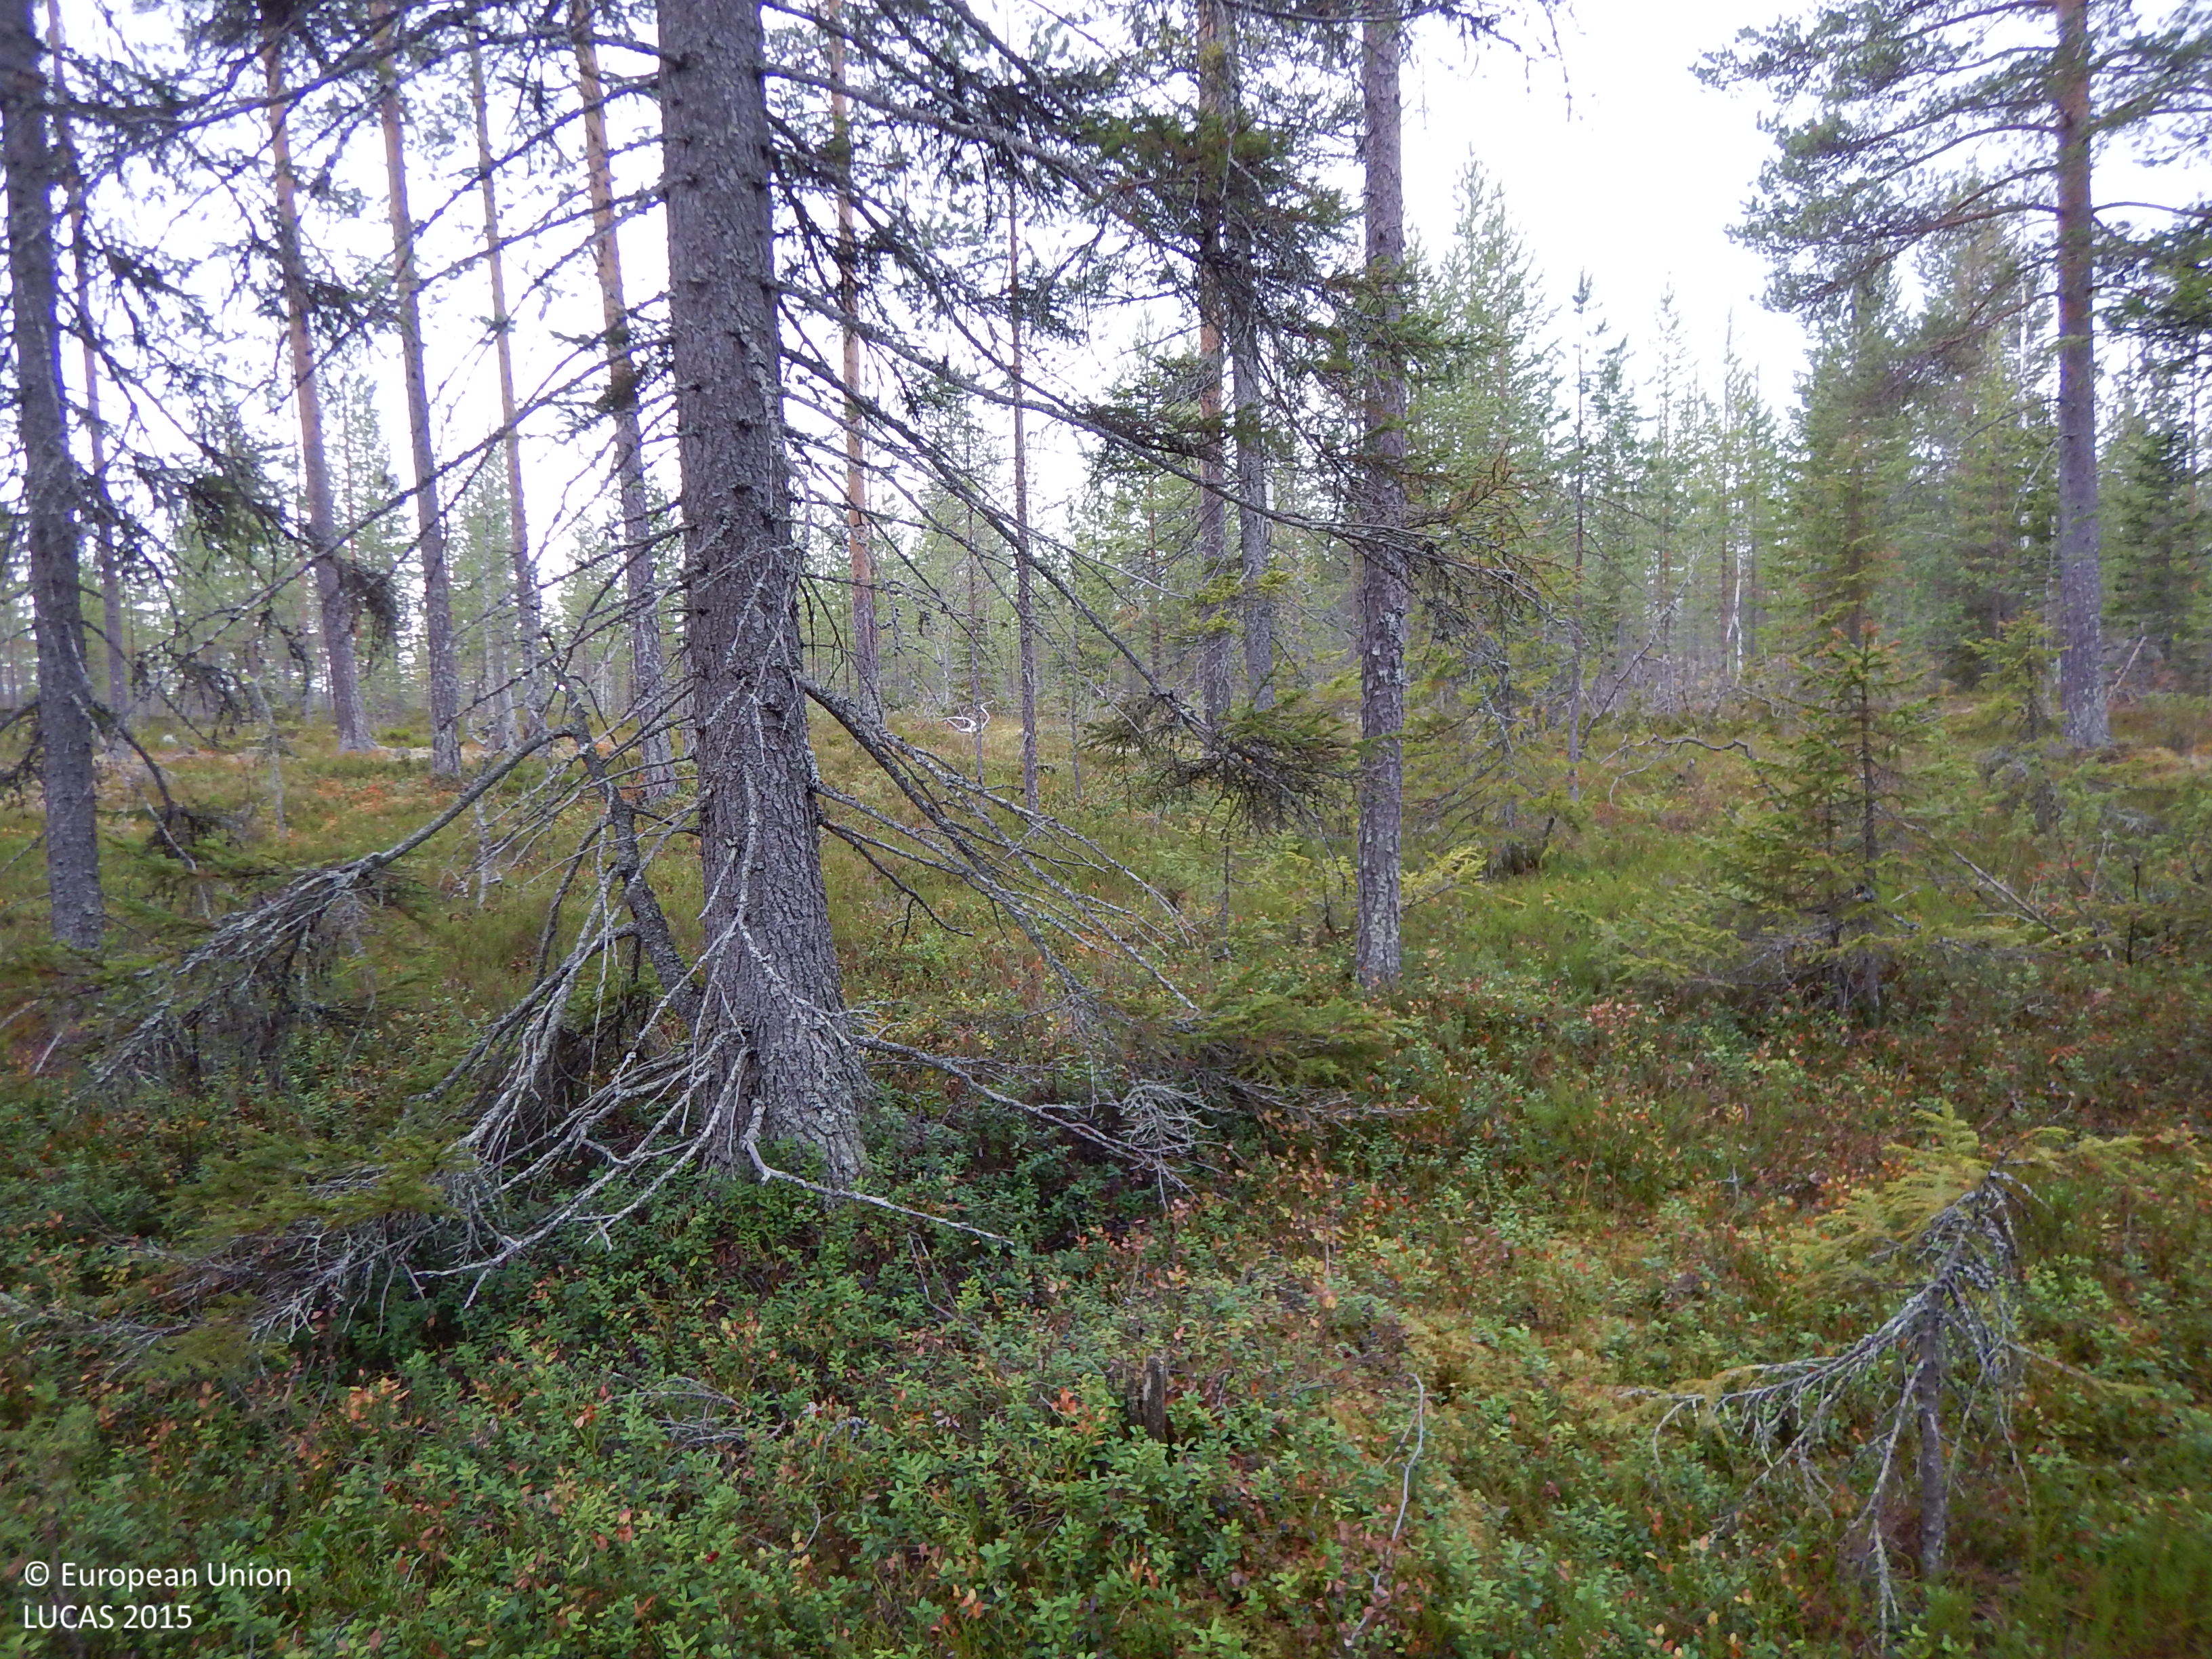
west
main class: Woodland
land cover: Other coniferous woodland
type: boreal forest
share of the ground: 50 - 75 %
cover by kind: coniferous forest trees 60 %, shrubs 20 %, herbaceous plants 10 %, lichens and mosses 10 %
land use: Forestry
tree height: > 5 m
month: October
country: SE
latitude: 65.2077
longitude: 21.1957
